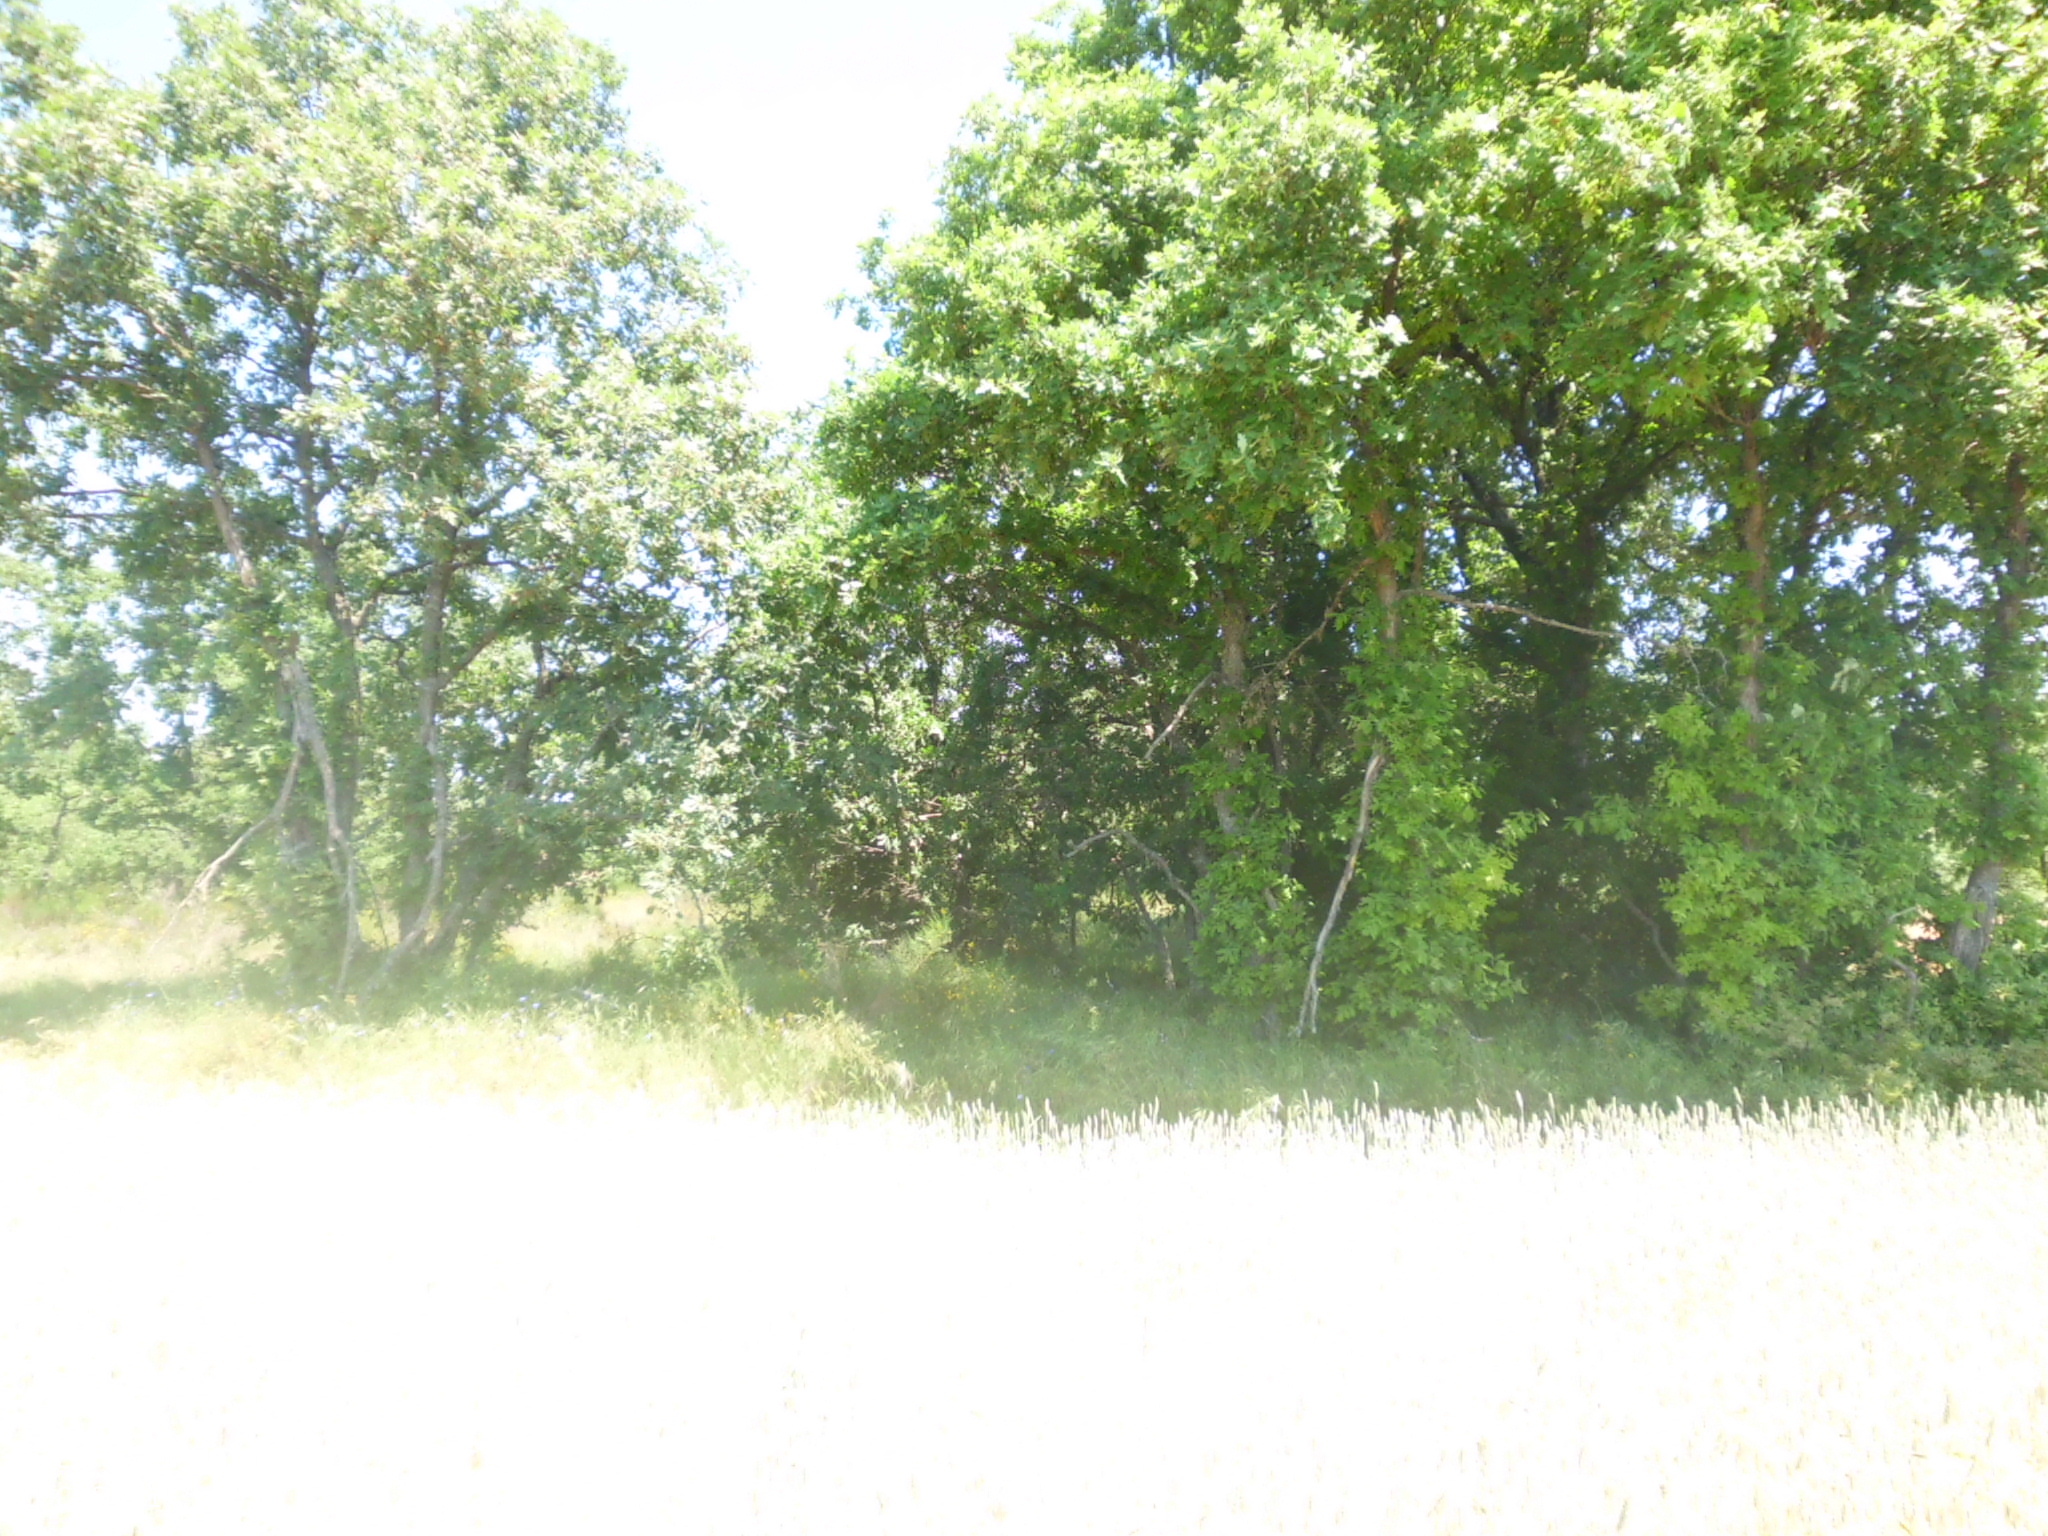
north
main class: Cropland
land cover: Common wheat
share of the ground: > 75 %
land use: Agriculture (excluding fallow land and kitchen gardens)
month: June
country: ES
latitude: 42.5933
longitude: -4.2451
